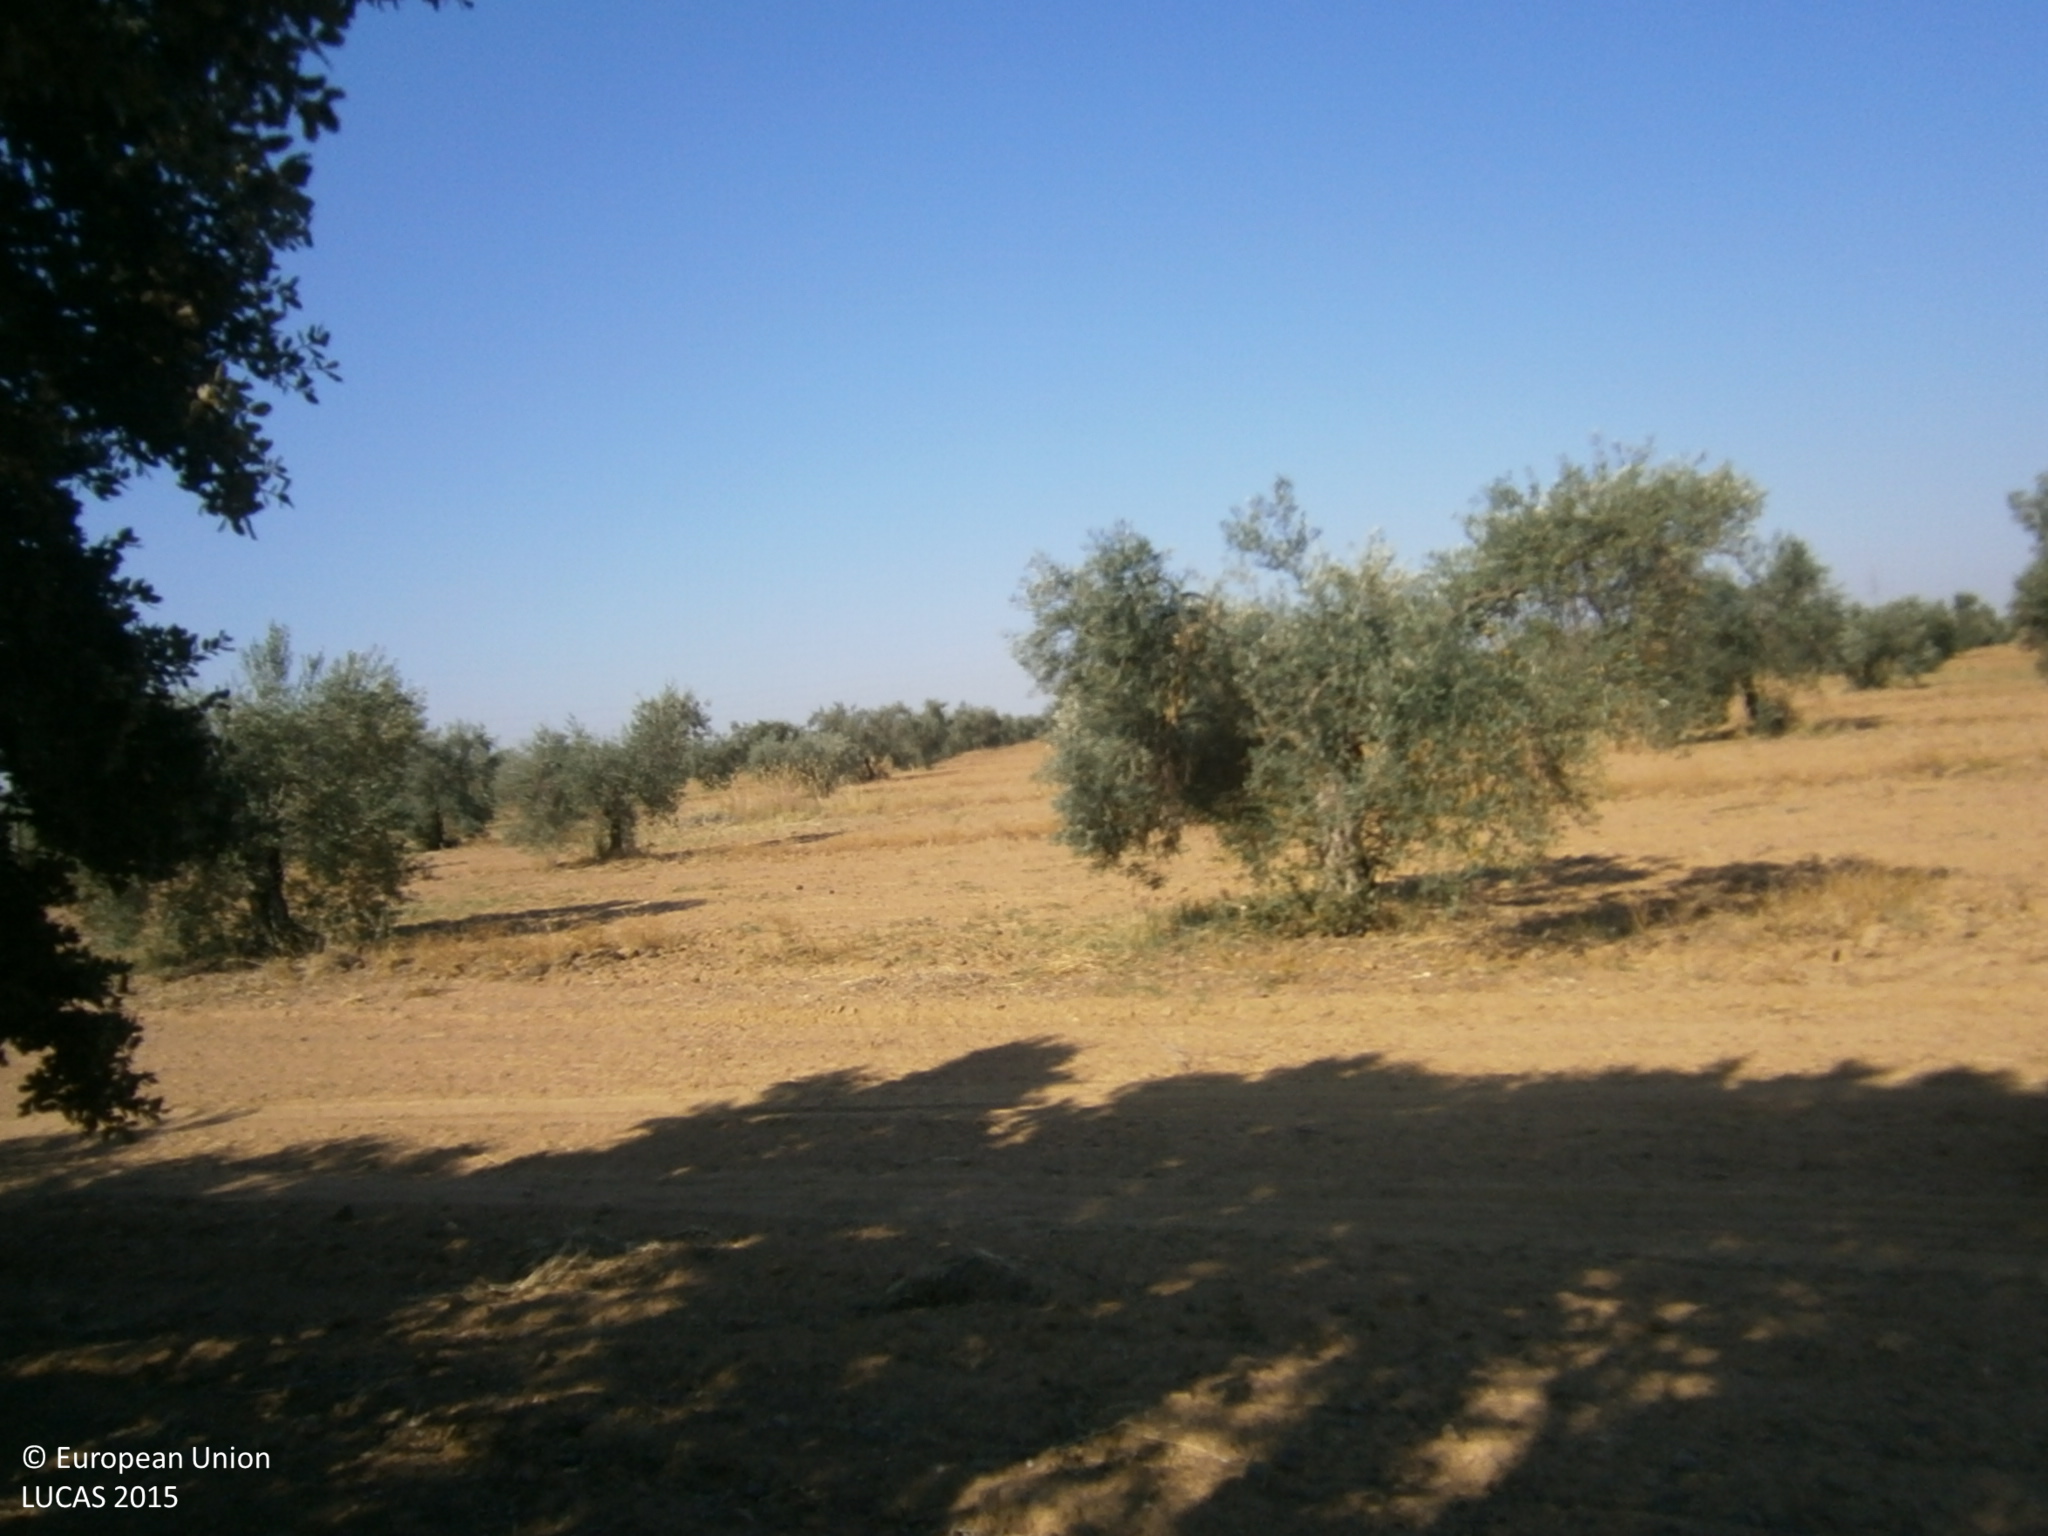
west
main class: Grassland
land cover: Grassland without tree/shrub cover
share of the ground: > 75 %
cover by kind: herbaceous plants 95 %, shrubs 5 %
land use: Agriculture (excluding fallow land and kitchen gardens)
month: June
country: ES
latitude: 38.8154
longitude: -6.7519
